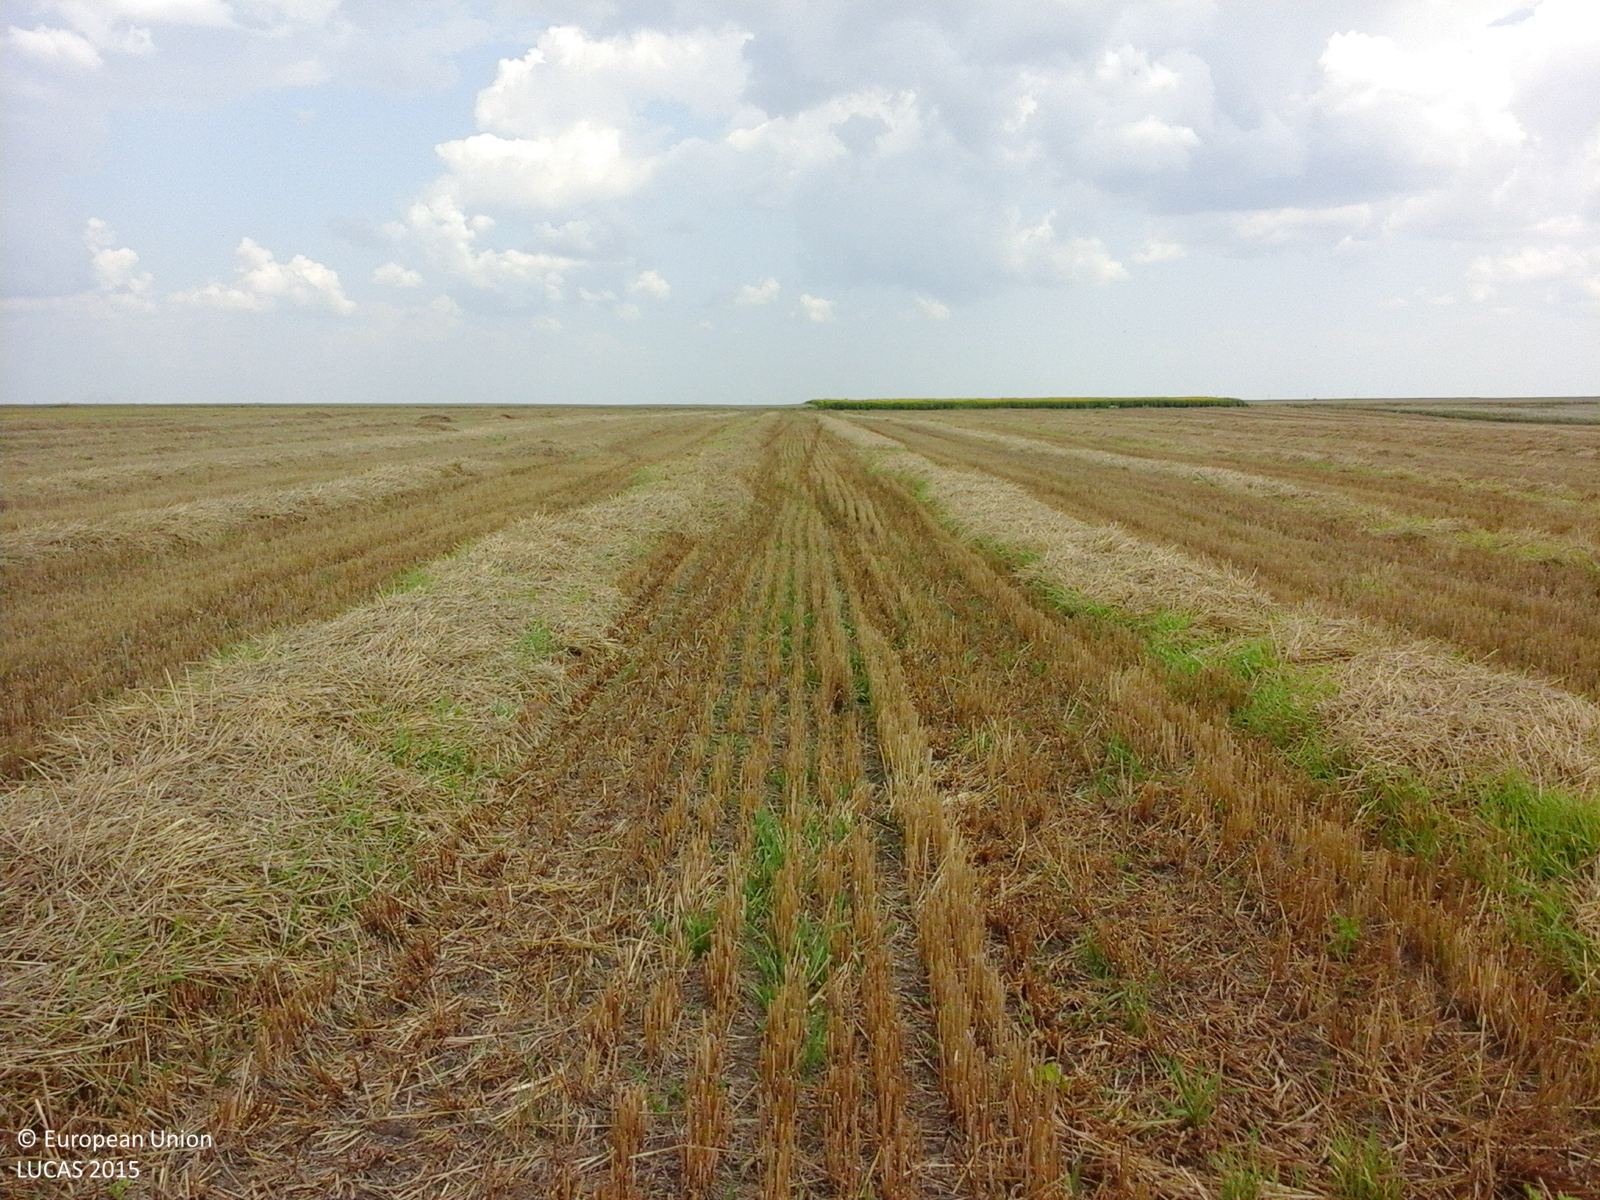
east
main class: Cropland
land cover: Common wheat
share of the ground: < 10 %
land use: Agriculture (excluding fallow land and kitchen gardens)
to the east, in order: Common wheat; Tracks; Grass margins; Sunflower
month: July
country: RO
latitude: 43.9654
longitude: 25.5041
